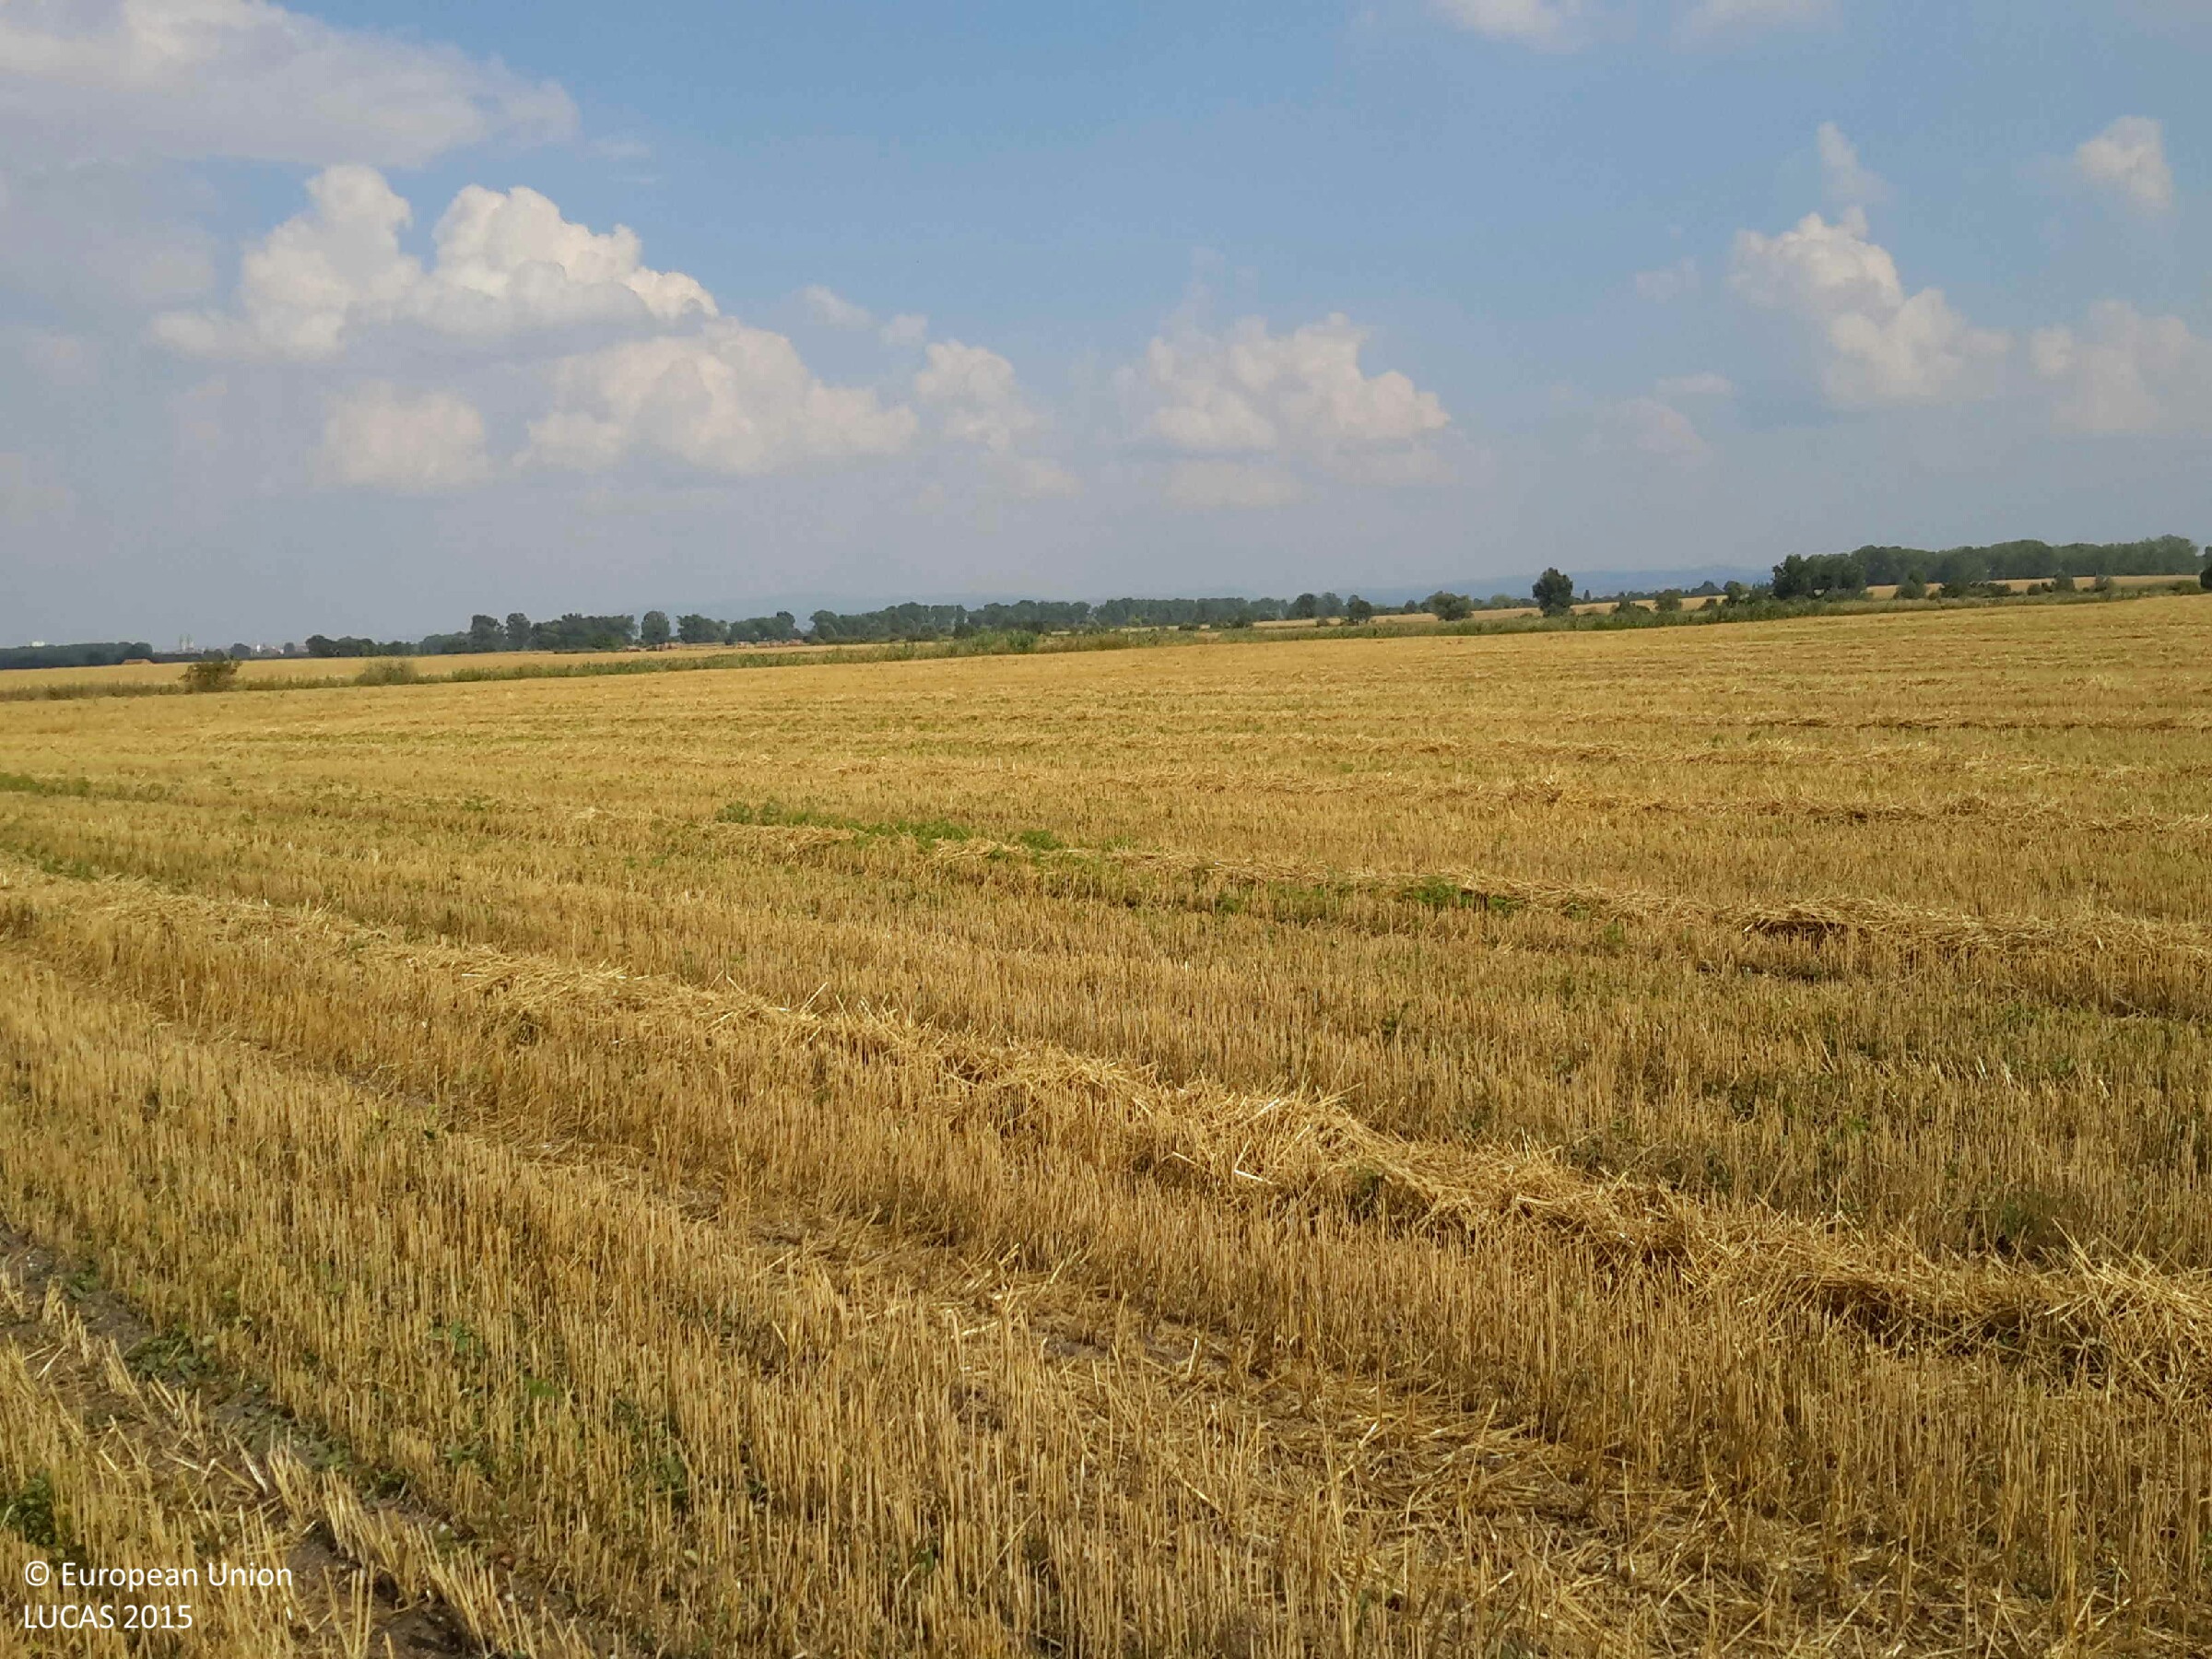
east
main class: Cropland
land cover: Common wheat
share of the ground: 50 - 75 %
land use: Agriculture (excluding fallow land and kitchen gardens)
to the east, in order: Common wheat; Grassland without tree/shrub cover; Rivers and streams; Grassland without tree/shrub cover; Common wheat
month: August
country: HU
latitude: 47.3239
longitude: 17.4033
